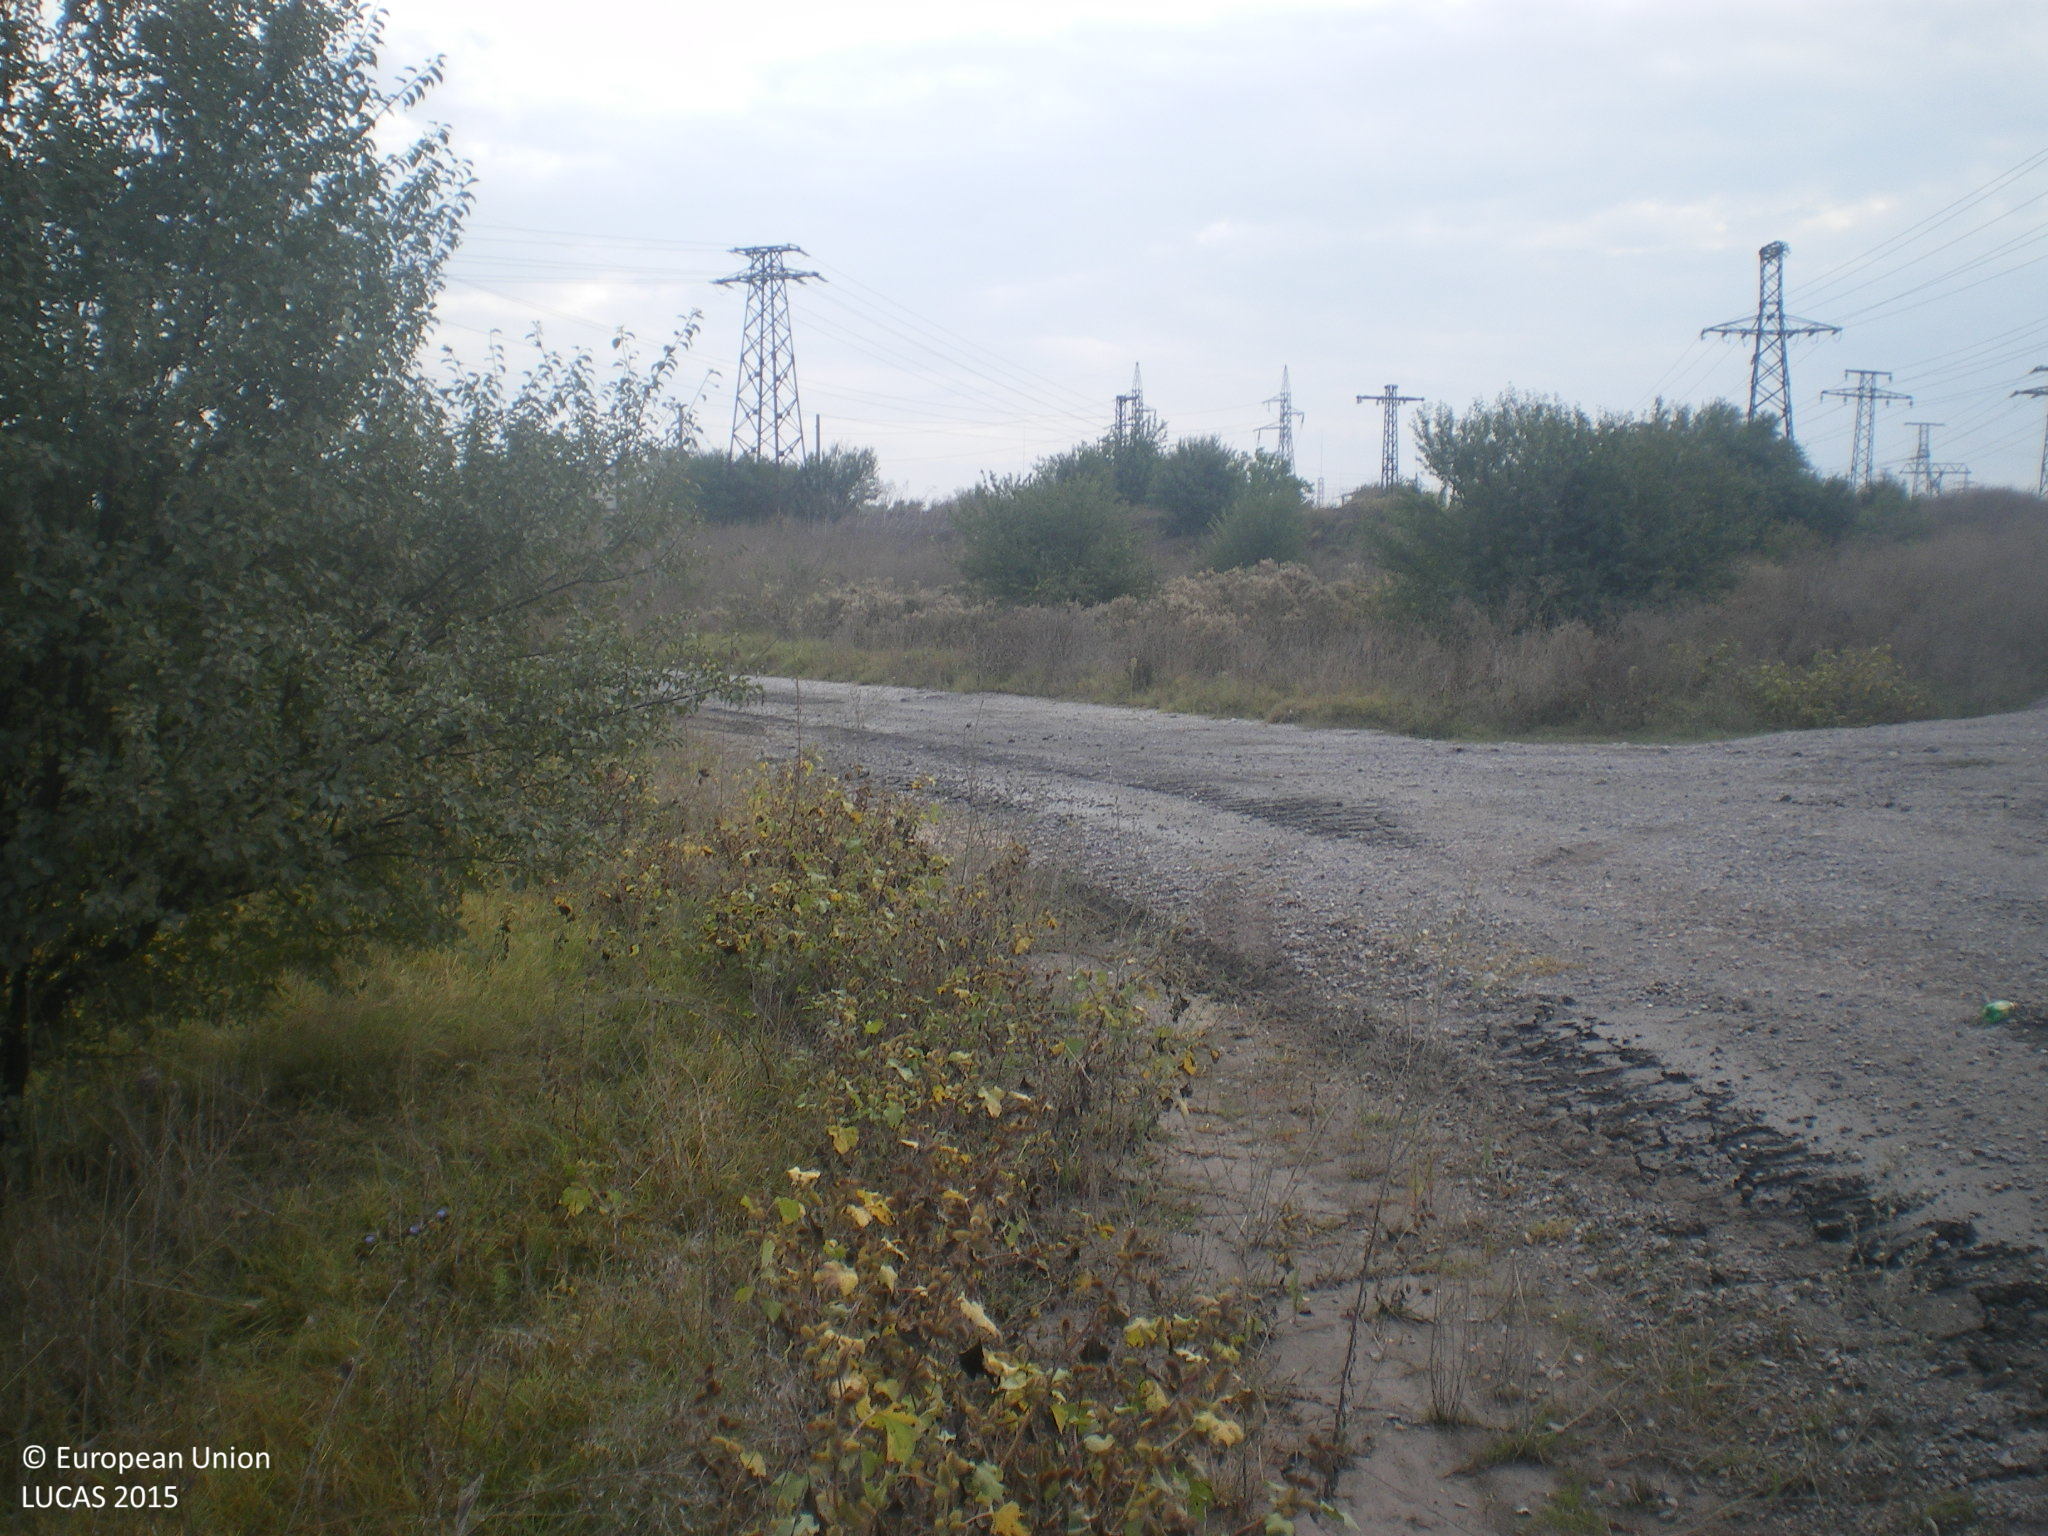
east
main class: Grassland
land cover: Grassland with sparse tree/shrub cover
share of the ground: > 75 %
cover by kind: herbaceous plants 90 %, broadleaved forest trees 5 %, shrubs 5 %
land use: Mining and quarrying
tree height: > 5 m
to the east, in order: Grassland with sparse tree/shrub cover; Tracks; Grassland with sparse tree/shrub cover; Electric lines; Grassland with sparse tree/shrub cover; Electric lines; Grassland with sparse tree/shrub cover; Electric lines; Grassland with sparse tree/shrub cover; Other structural elements; Grassland without tree/shrub cover; Broadleaved woodland; Shrubland without tree cover
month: October
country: BG
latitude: 42.2518
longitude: 26.0168
